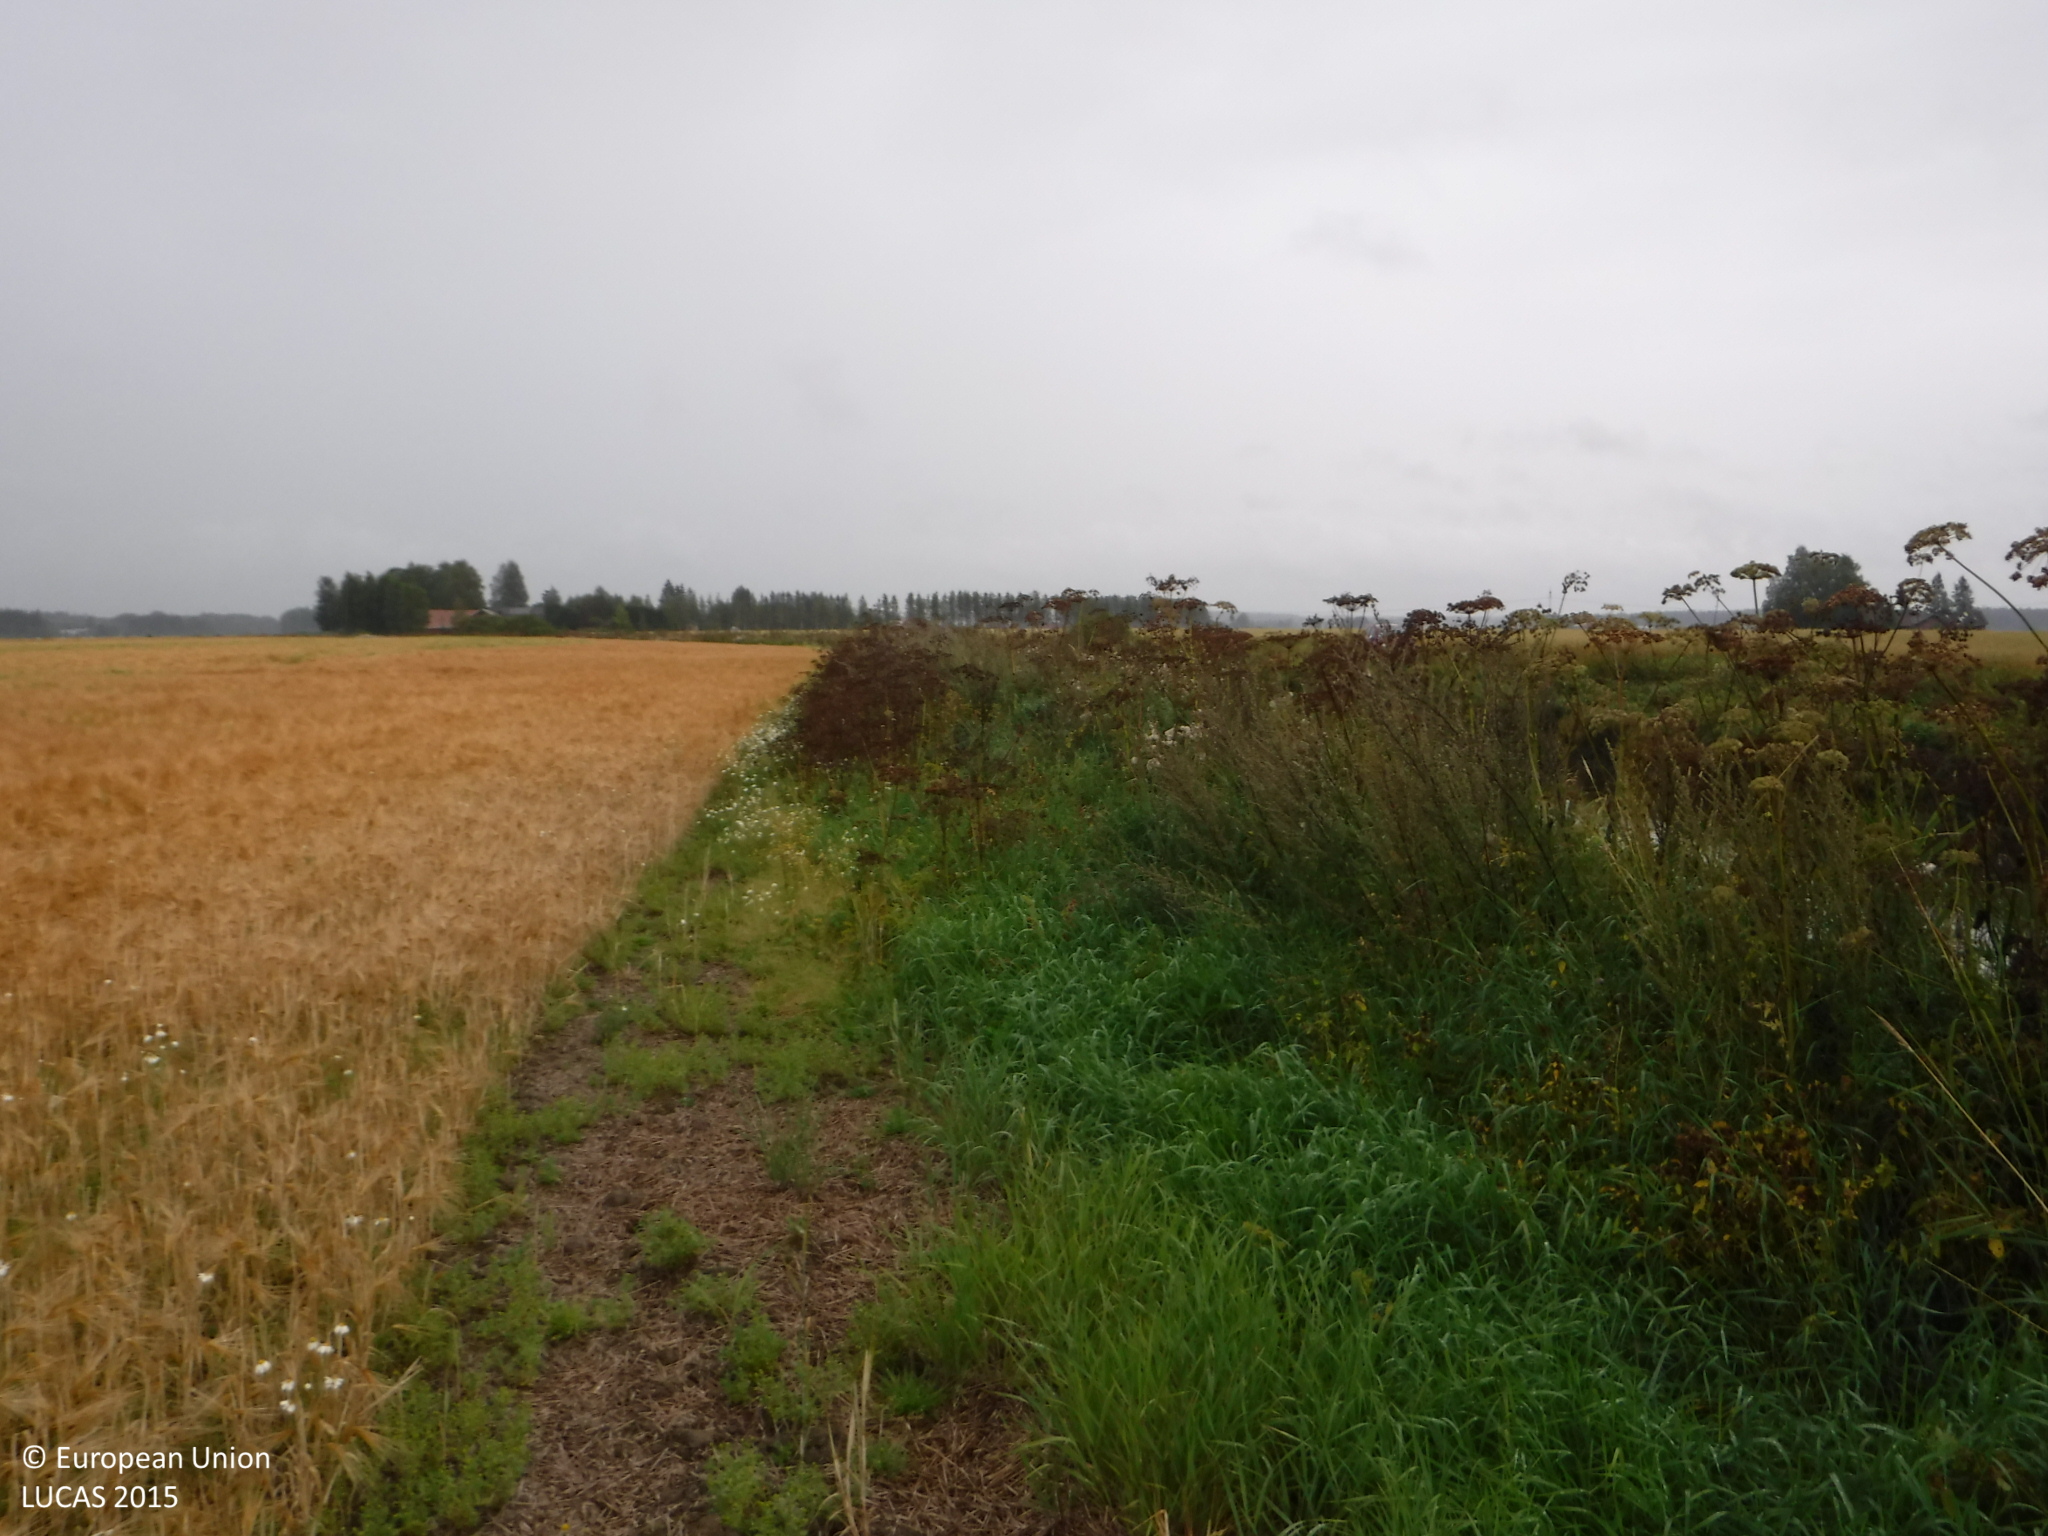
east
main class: Cropland
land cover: Barley
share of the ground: > 75 %
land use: Agriculture (excluding fallow land and kitchen gardens)
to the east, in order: Barley
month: August
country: FI
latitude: 61.2095
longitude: 22.9340
